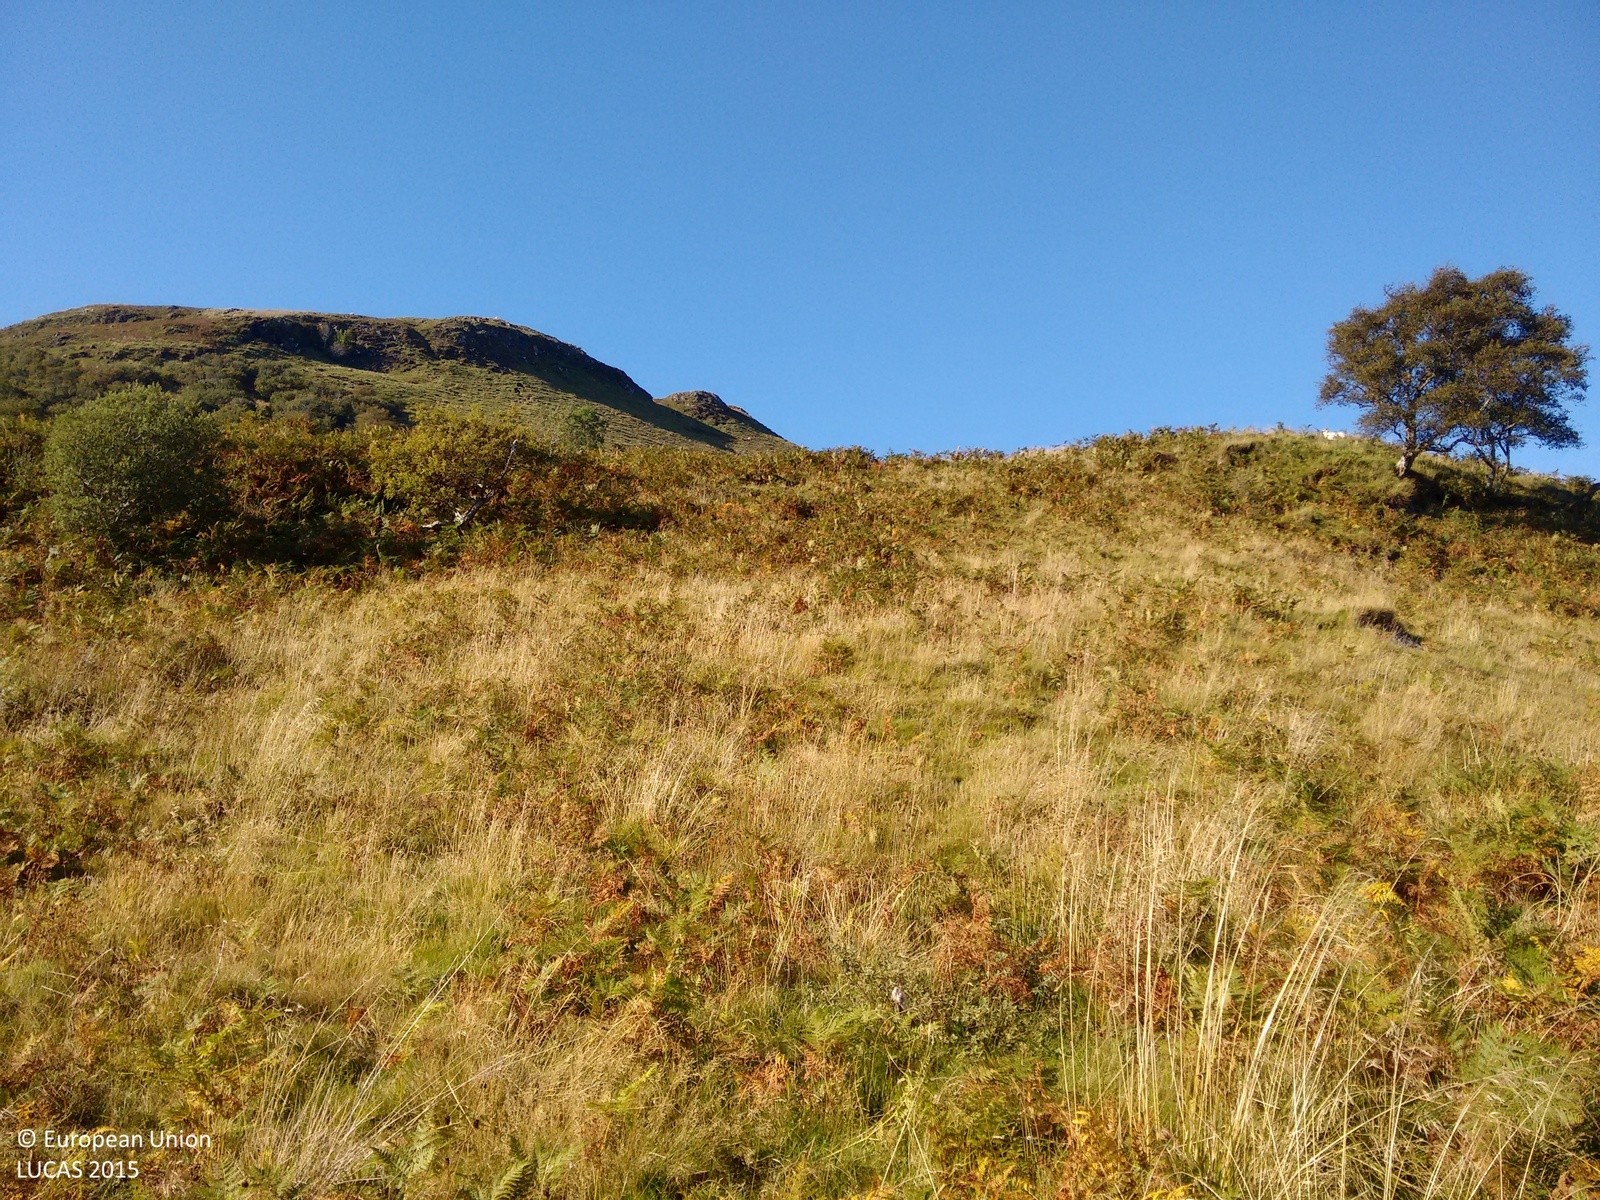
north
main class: Woodland
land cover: Broadleaved woodland
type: non-riverine alder, birch or aspen forest
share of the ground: > 75 %
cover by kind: broadleaved forest trees 95 %, shrubs 5 %
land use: Semi-natural and natural areas not in use
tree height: > 5 m
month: August
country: GB
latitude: 56.2565
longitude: -5.5710
